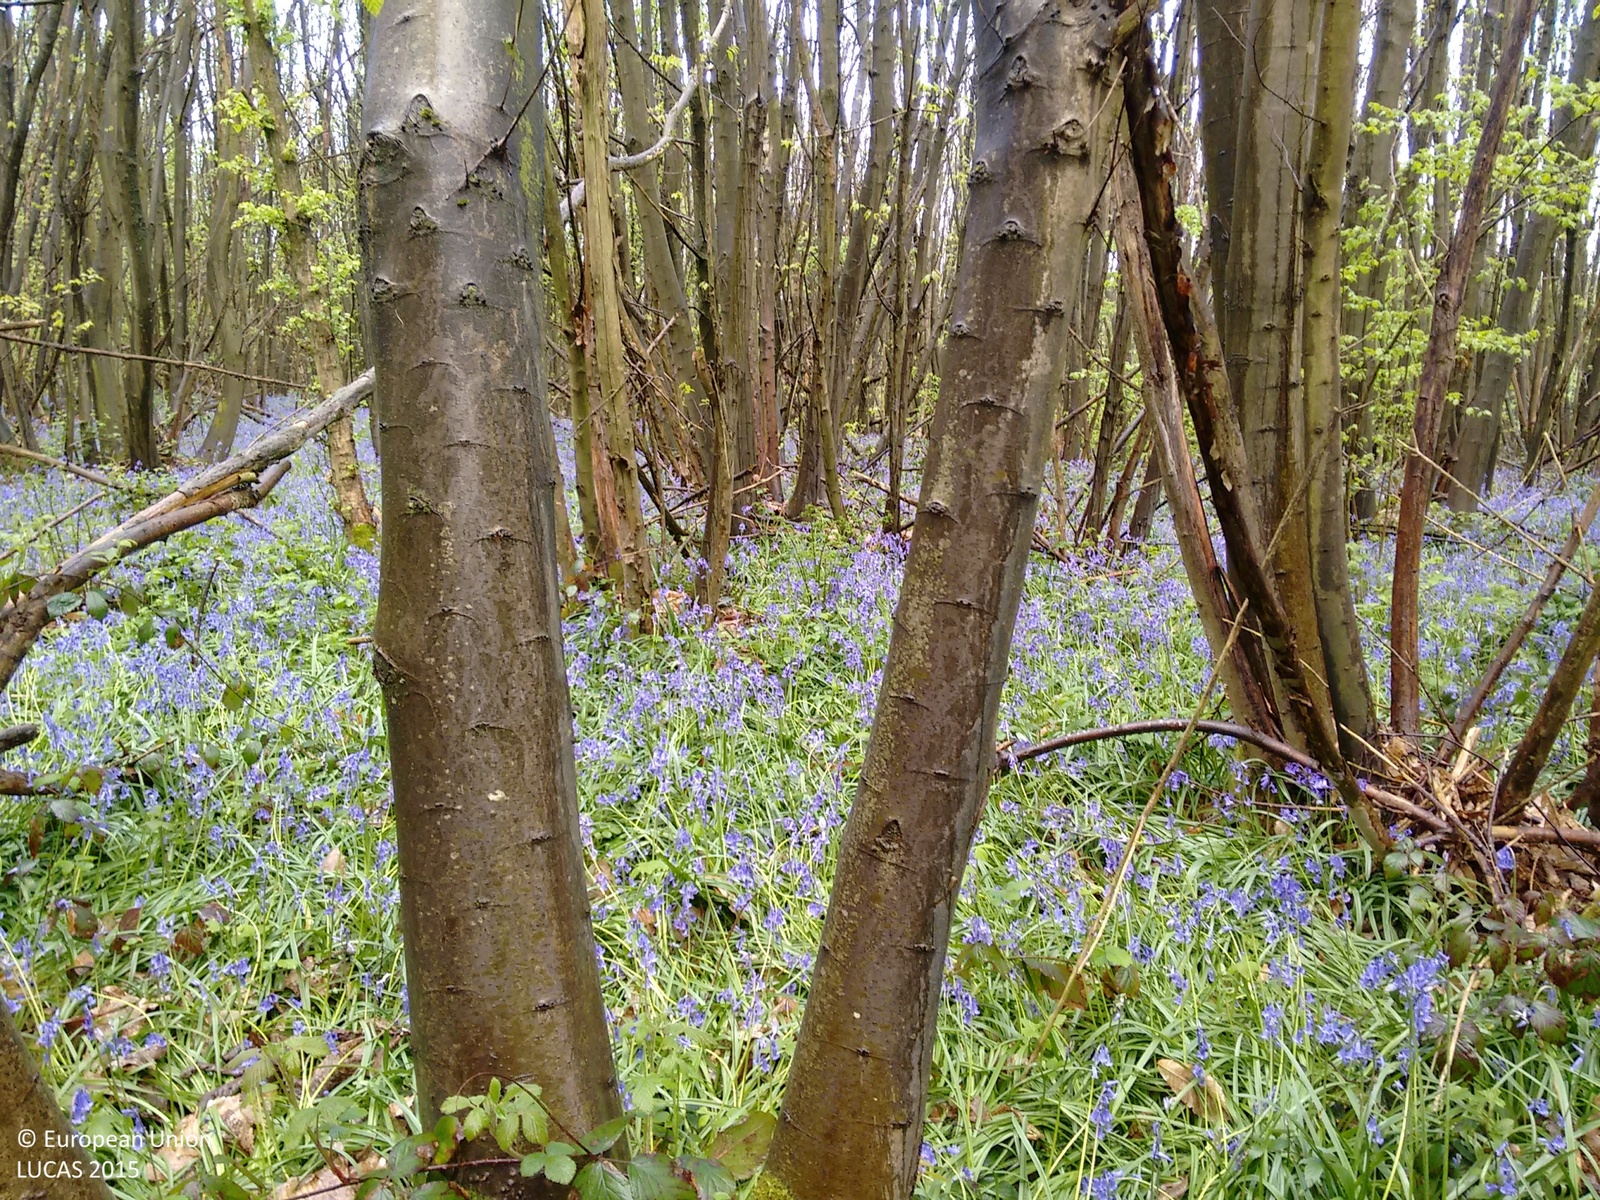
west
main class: Woodland
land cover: Broadleaved woodland
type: mesophytic deciduous forest
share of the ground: > 75 %
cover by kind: broadleaved forest trees 100 %
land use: Forestry
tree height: > 5 m
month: May
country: GB
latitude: 51.3212
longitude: 0.2263
